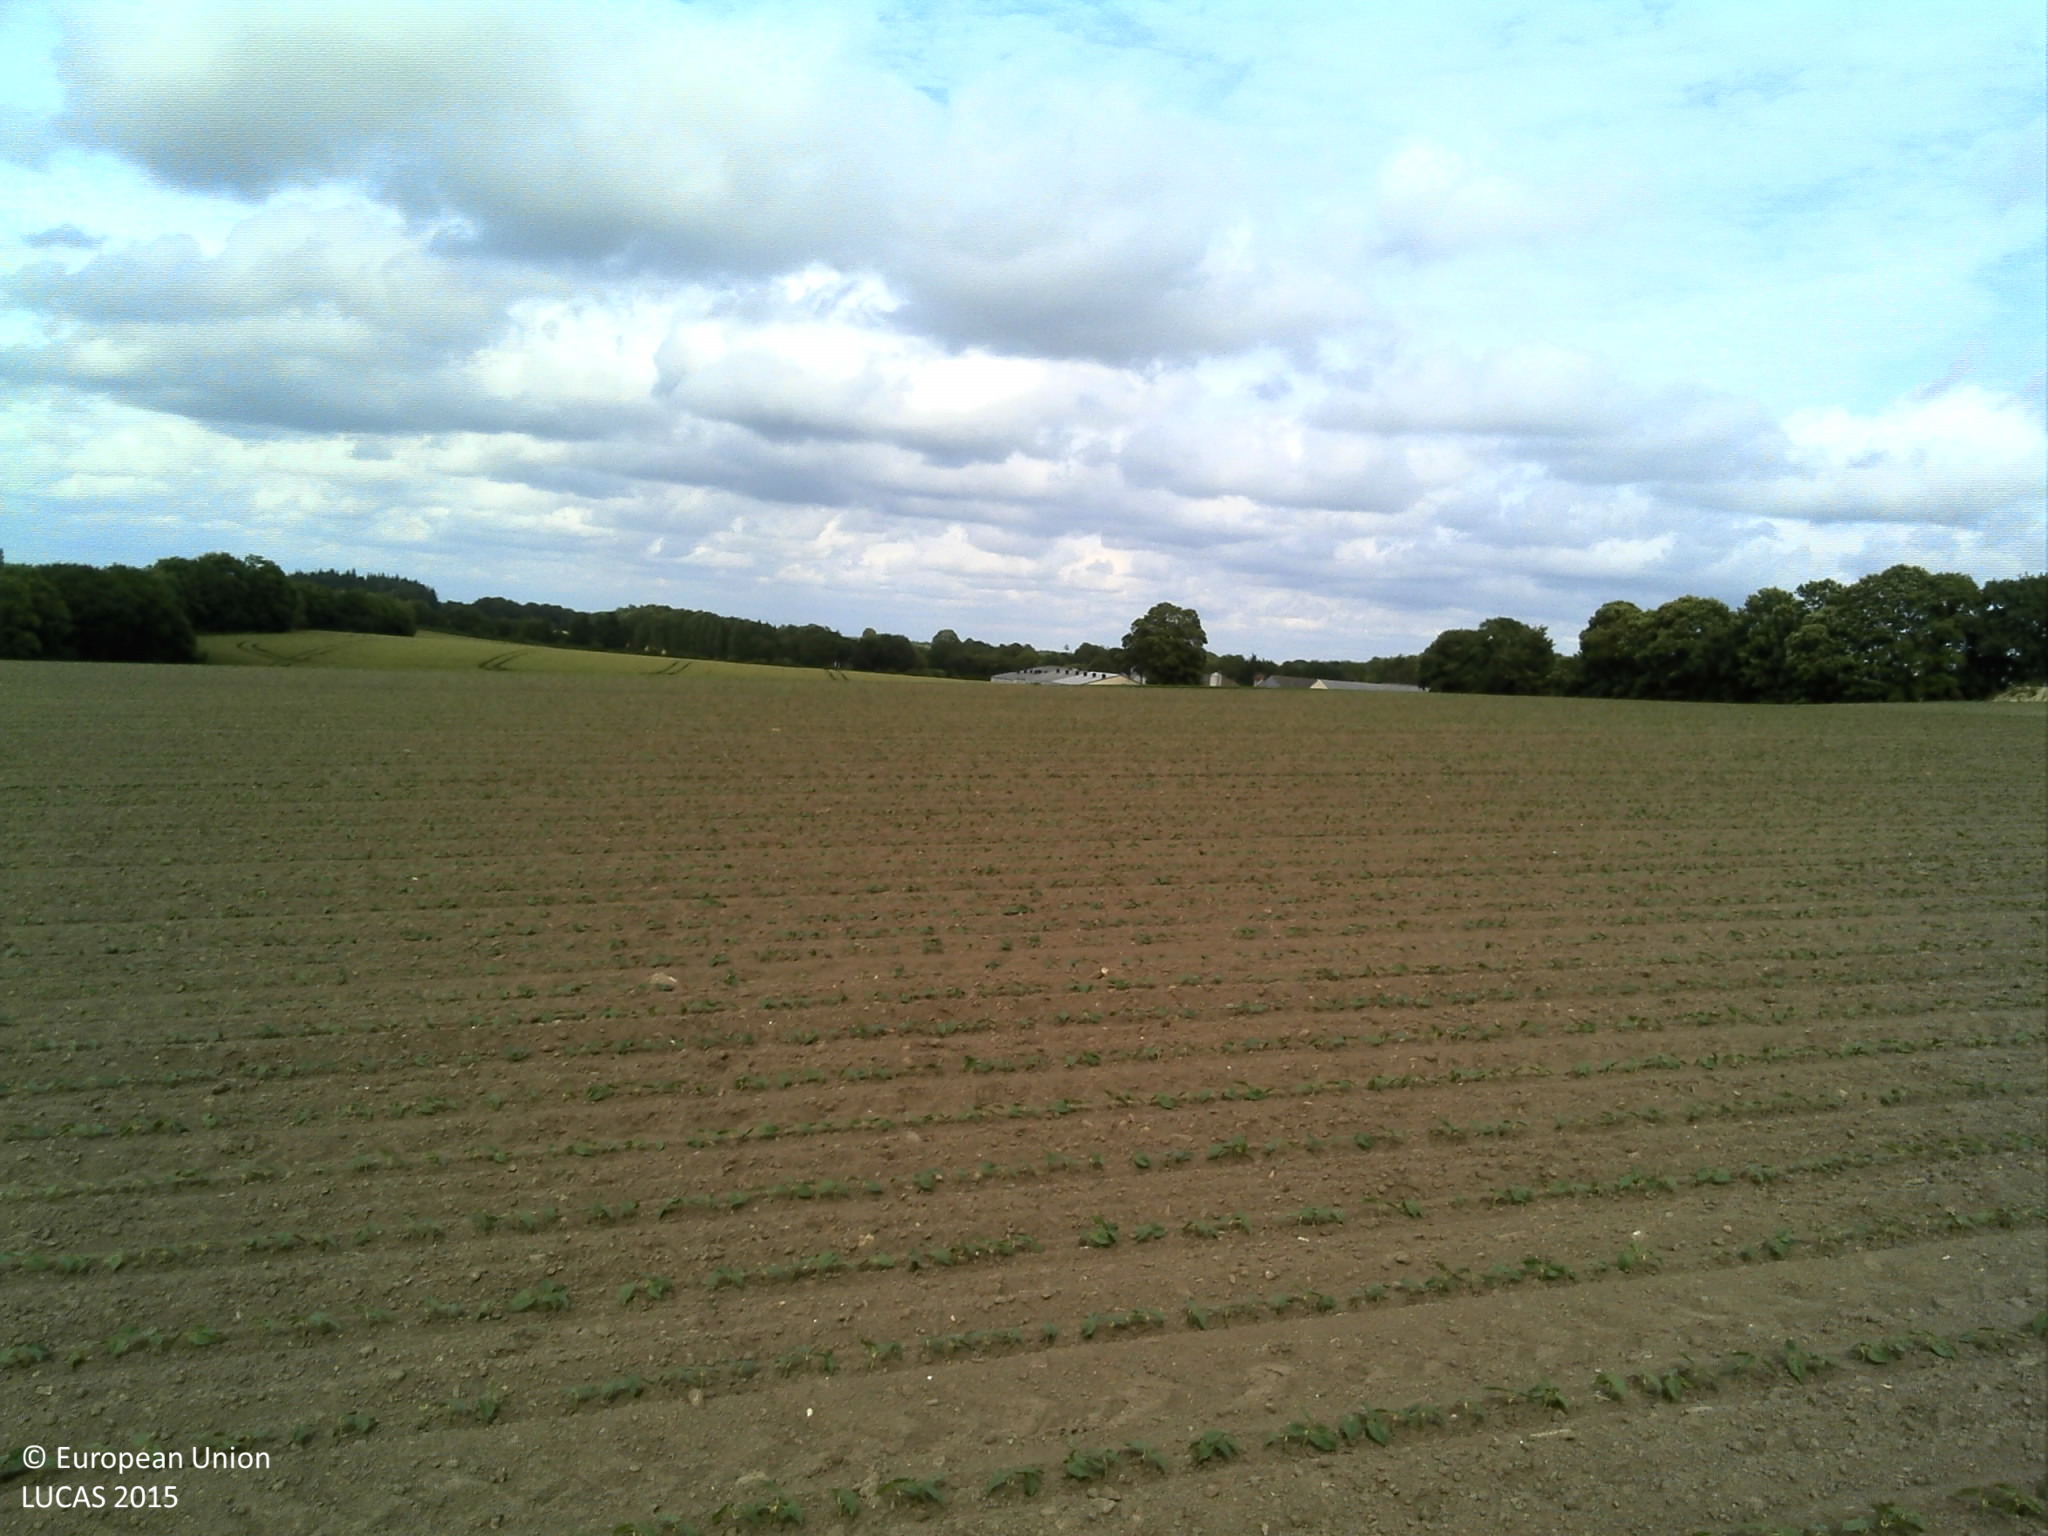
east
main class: Cropland
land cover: Other fresh vegetables
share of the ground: < 10 %
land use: Agriculture (excluding fallow land and kitchen gardens)
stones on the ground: 10 - 25 %
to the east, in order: Other fresh vegetables; Other root crops
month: June
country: FR
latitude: 47.9079
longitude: -3.5768
